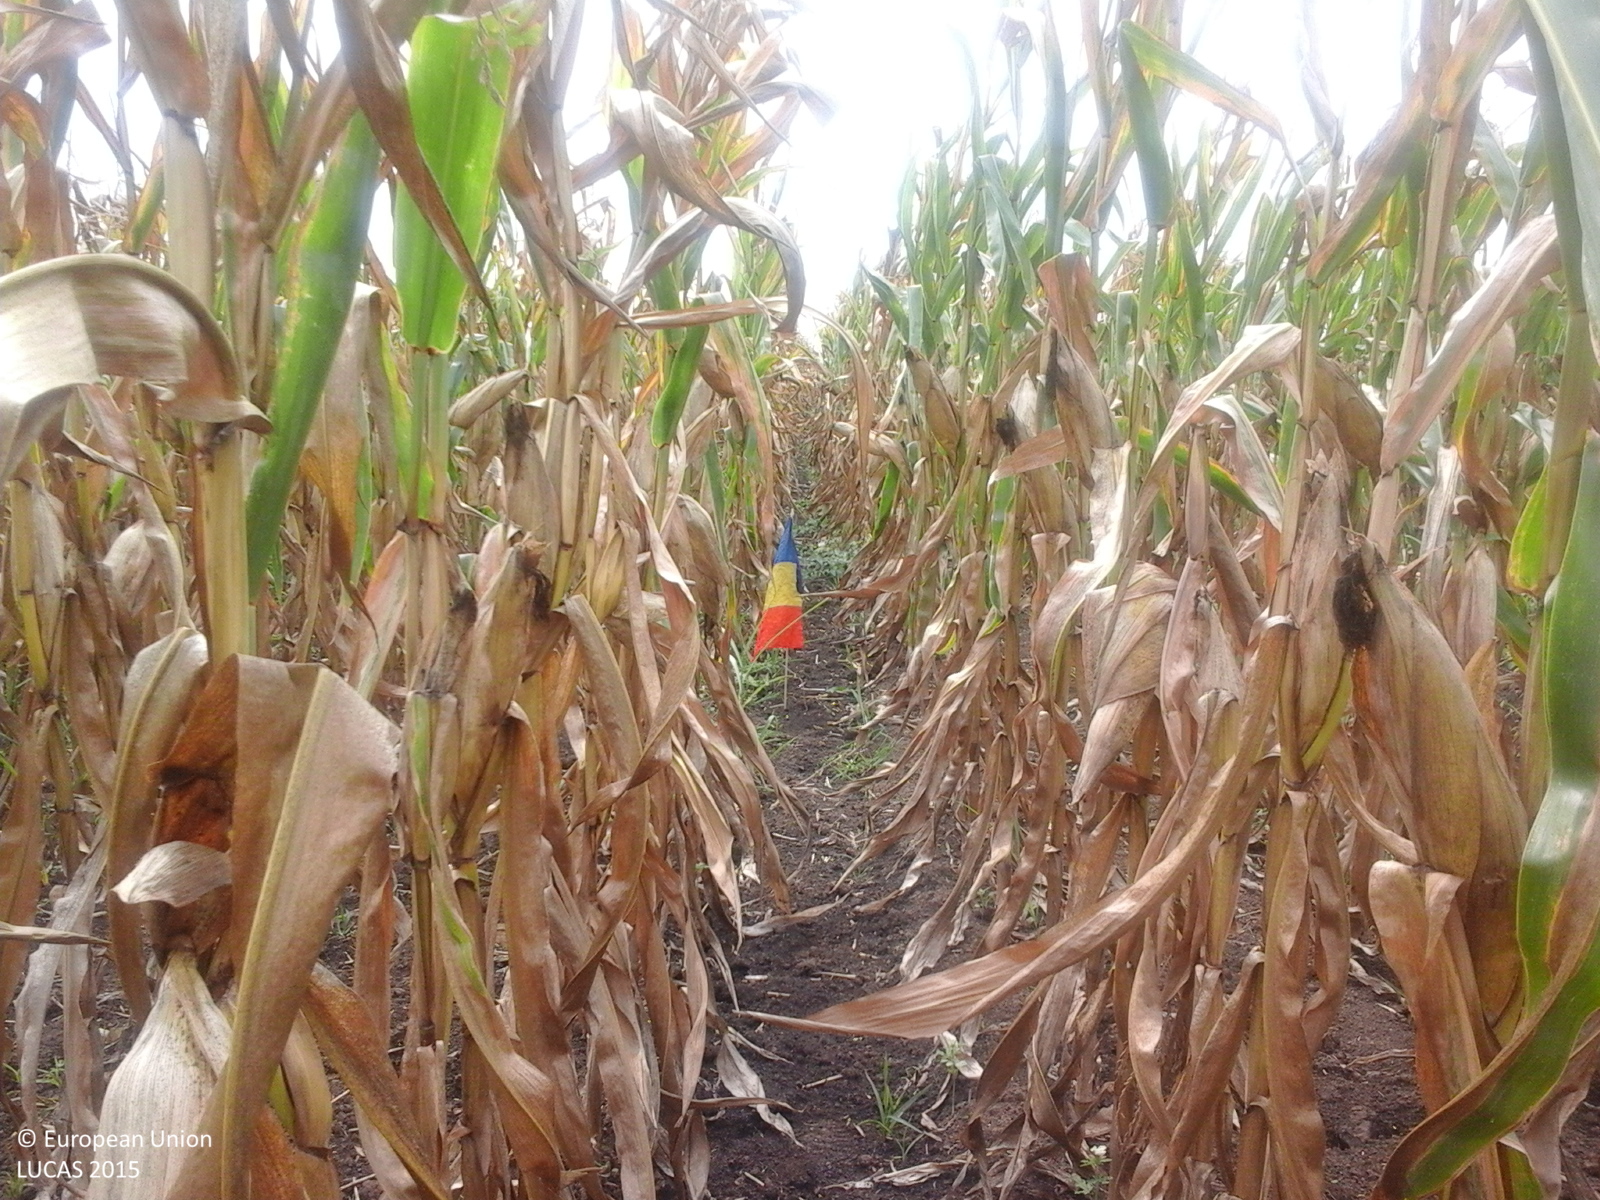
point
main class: Cropland
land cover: Maize
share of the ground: > 75 %
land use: Agriculture (excluding fallow land and kitchen gardens)
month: August
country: RO
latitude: 46.3431
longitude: 21.5362
